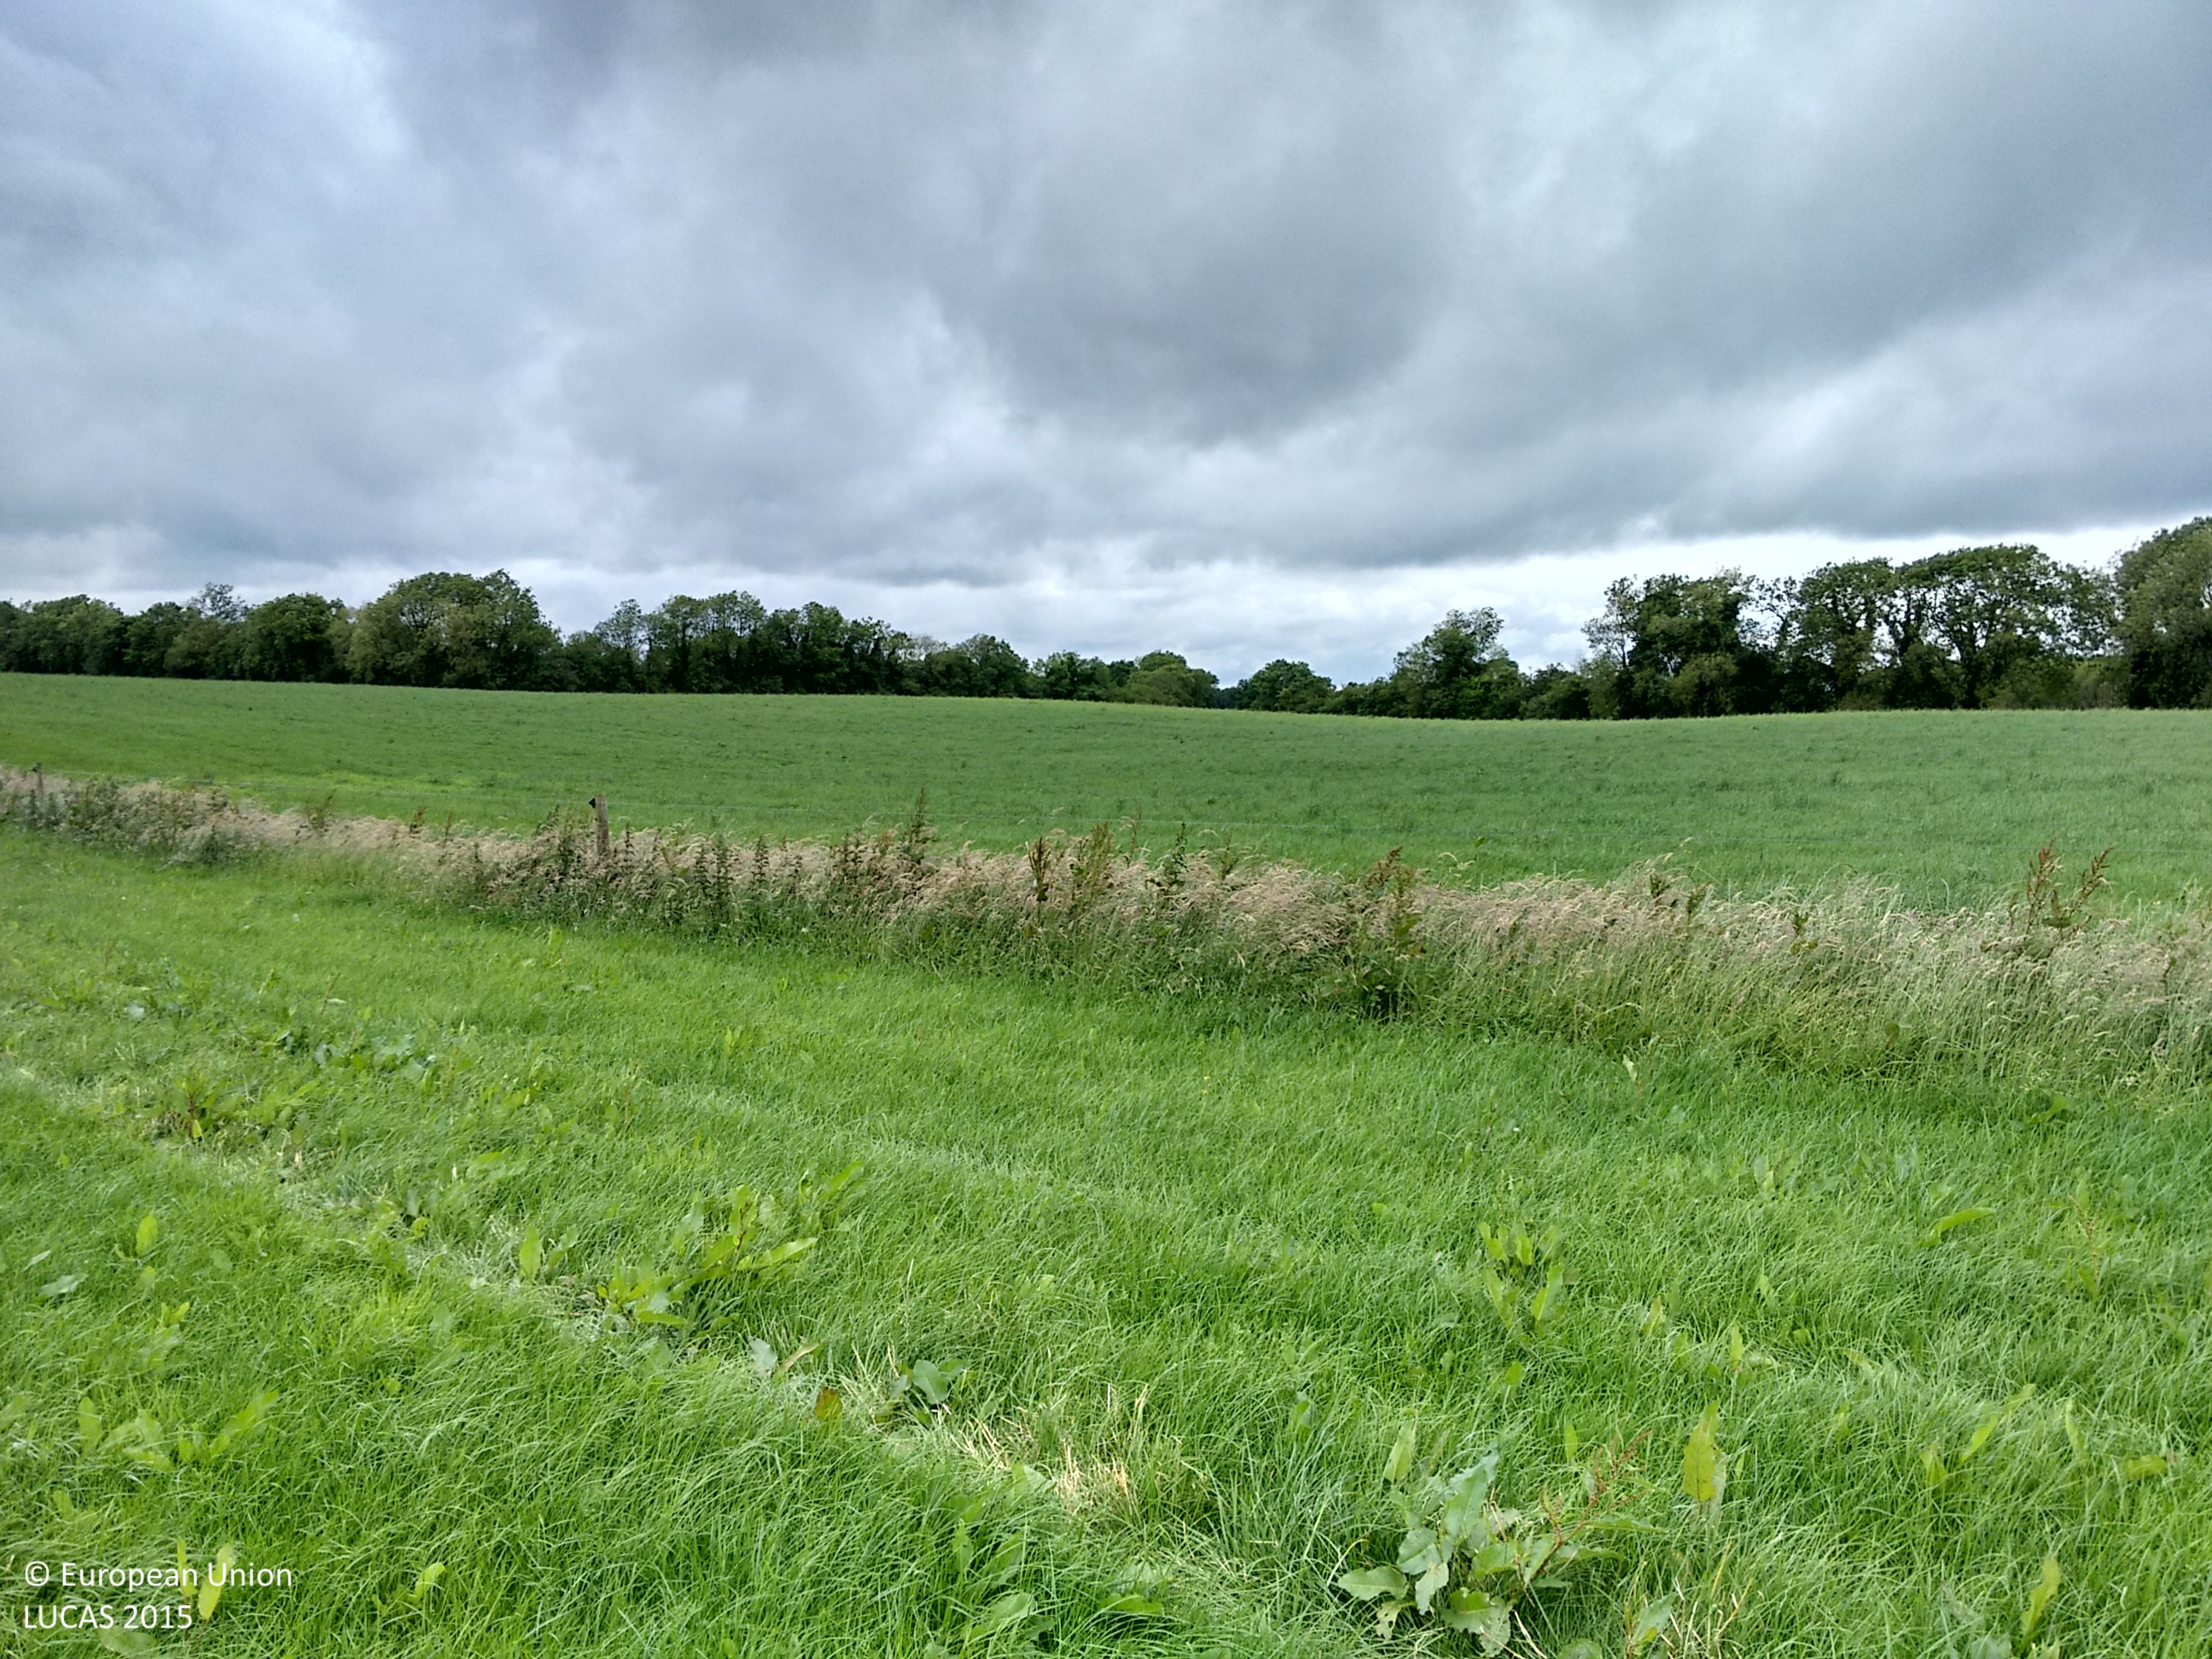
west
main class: Grassland
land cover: Grassland without tree/shrub cover
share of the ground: > 75 %
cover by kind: herbaceous plants 100 %
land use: Agriculture (excluding fallow land and kitchen gardens)
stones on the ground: < 10 %
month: July
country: IE
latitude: 53.5966
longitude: -7.0512
